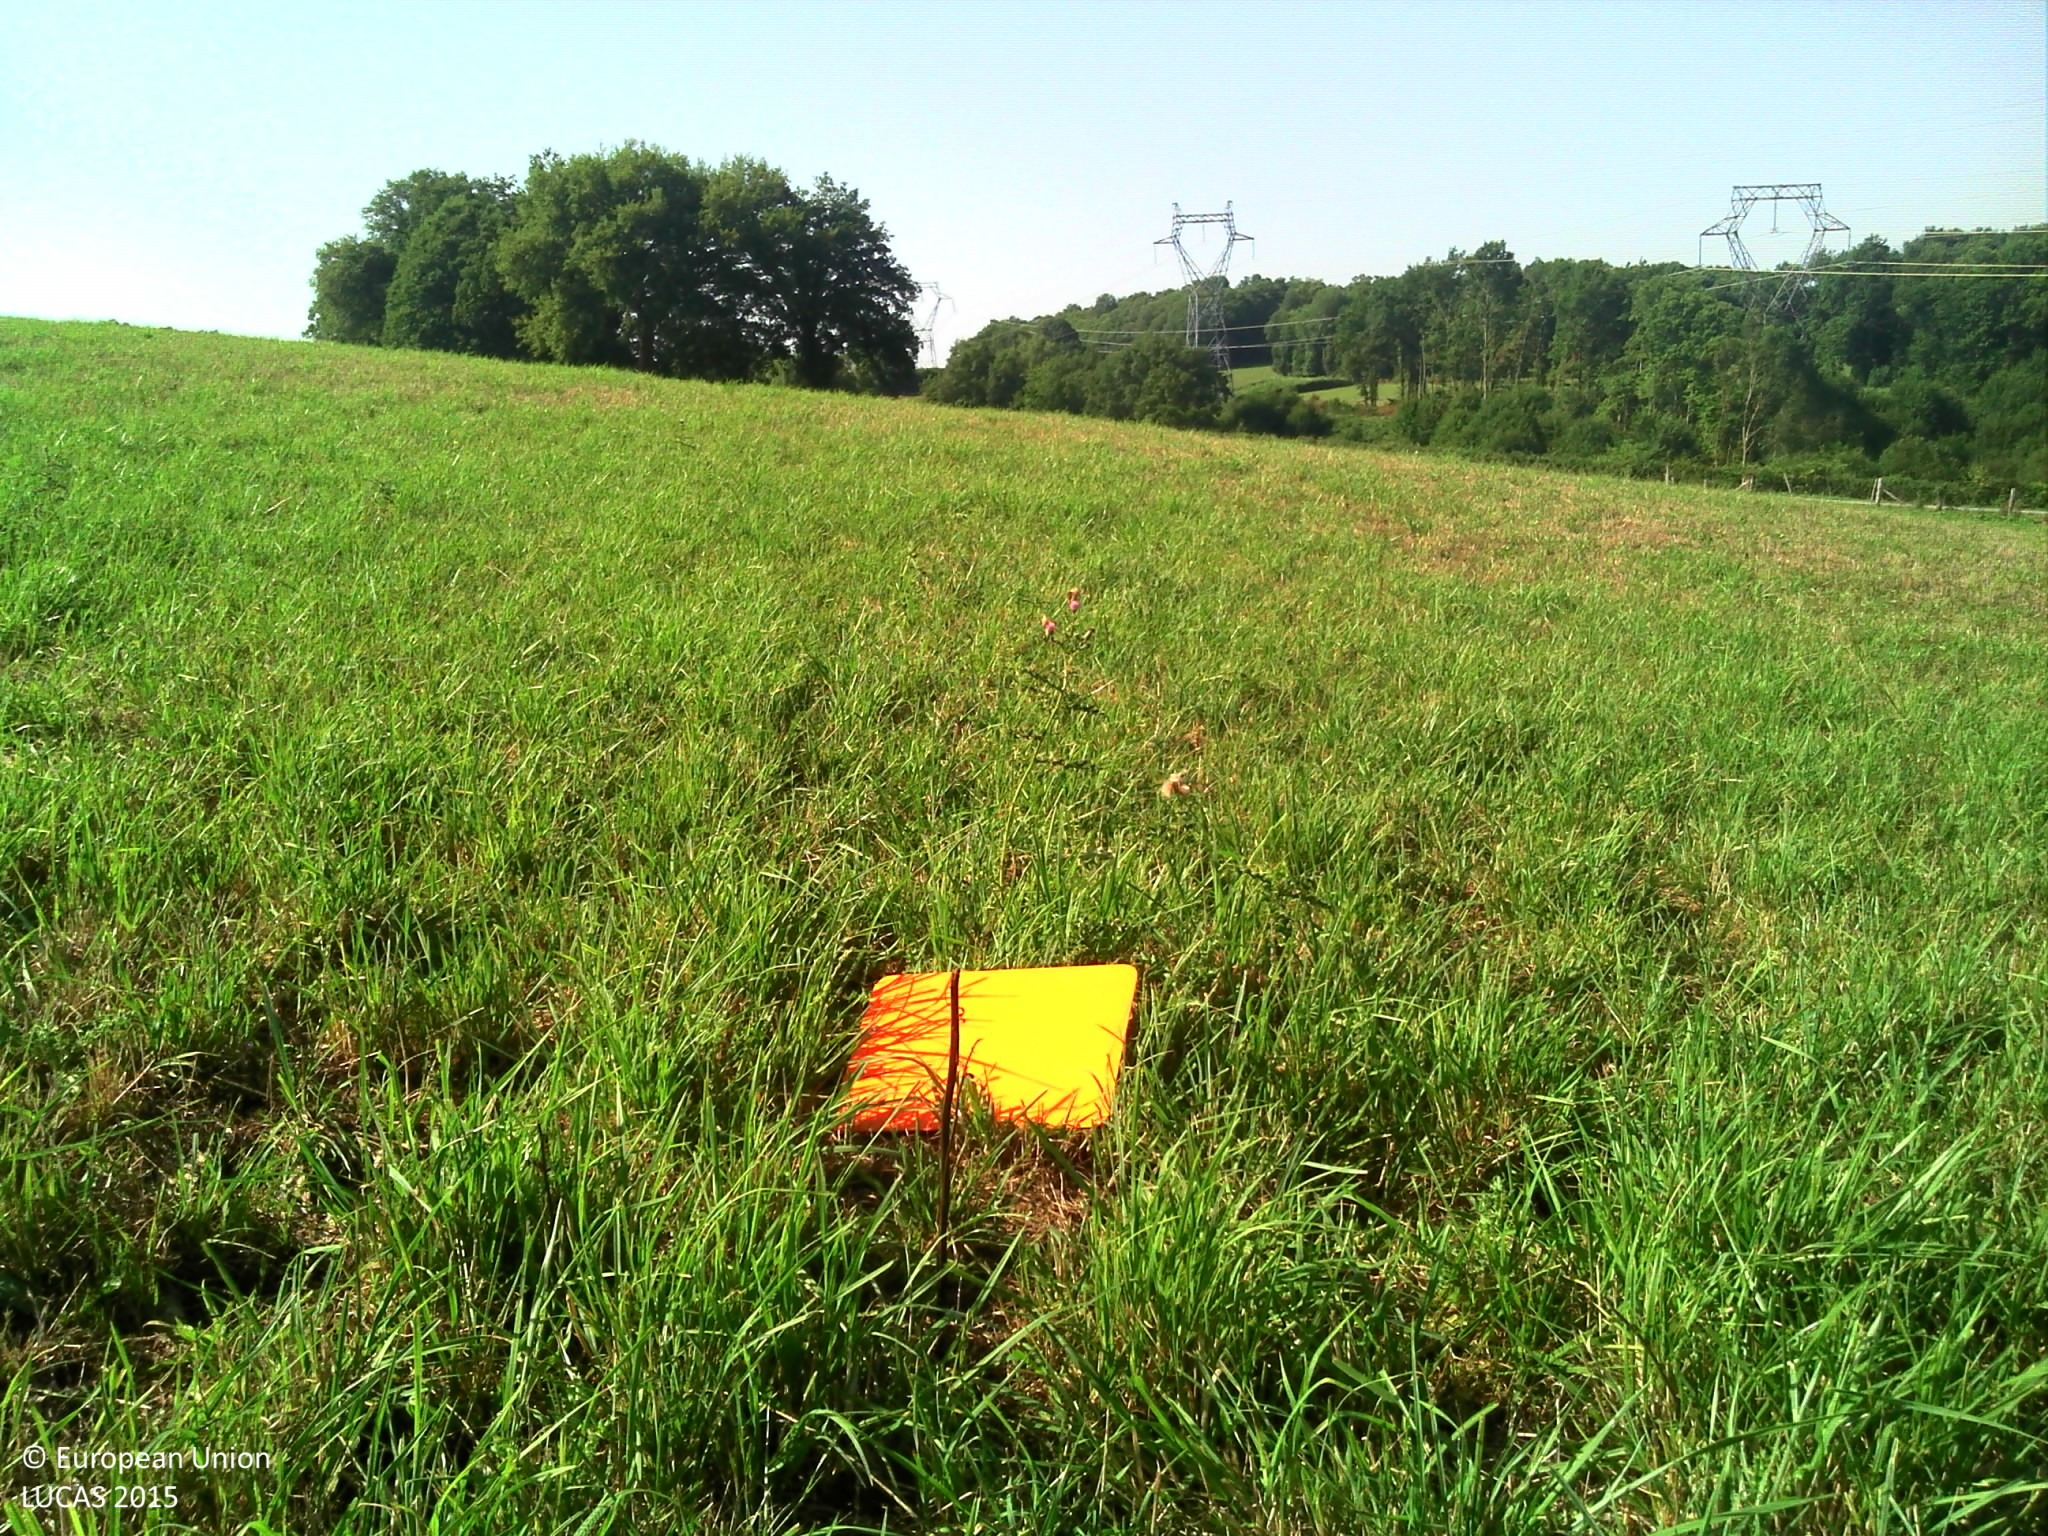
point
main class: Cropland
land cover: Temporary grasslands
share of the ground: > 75 %
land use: Agriculture (excluding fallow land and kitchen gardens)
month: August
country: FR
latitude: 46.1881
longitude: 1.6609
